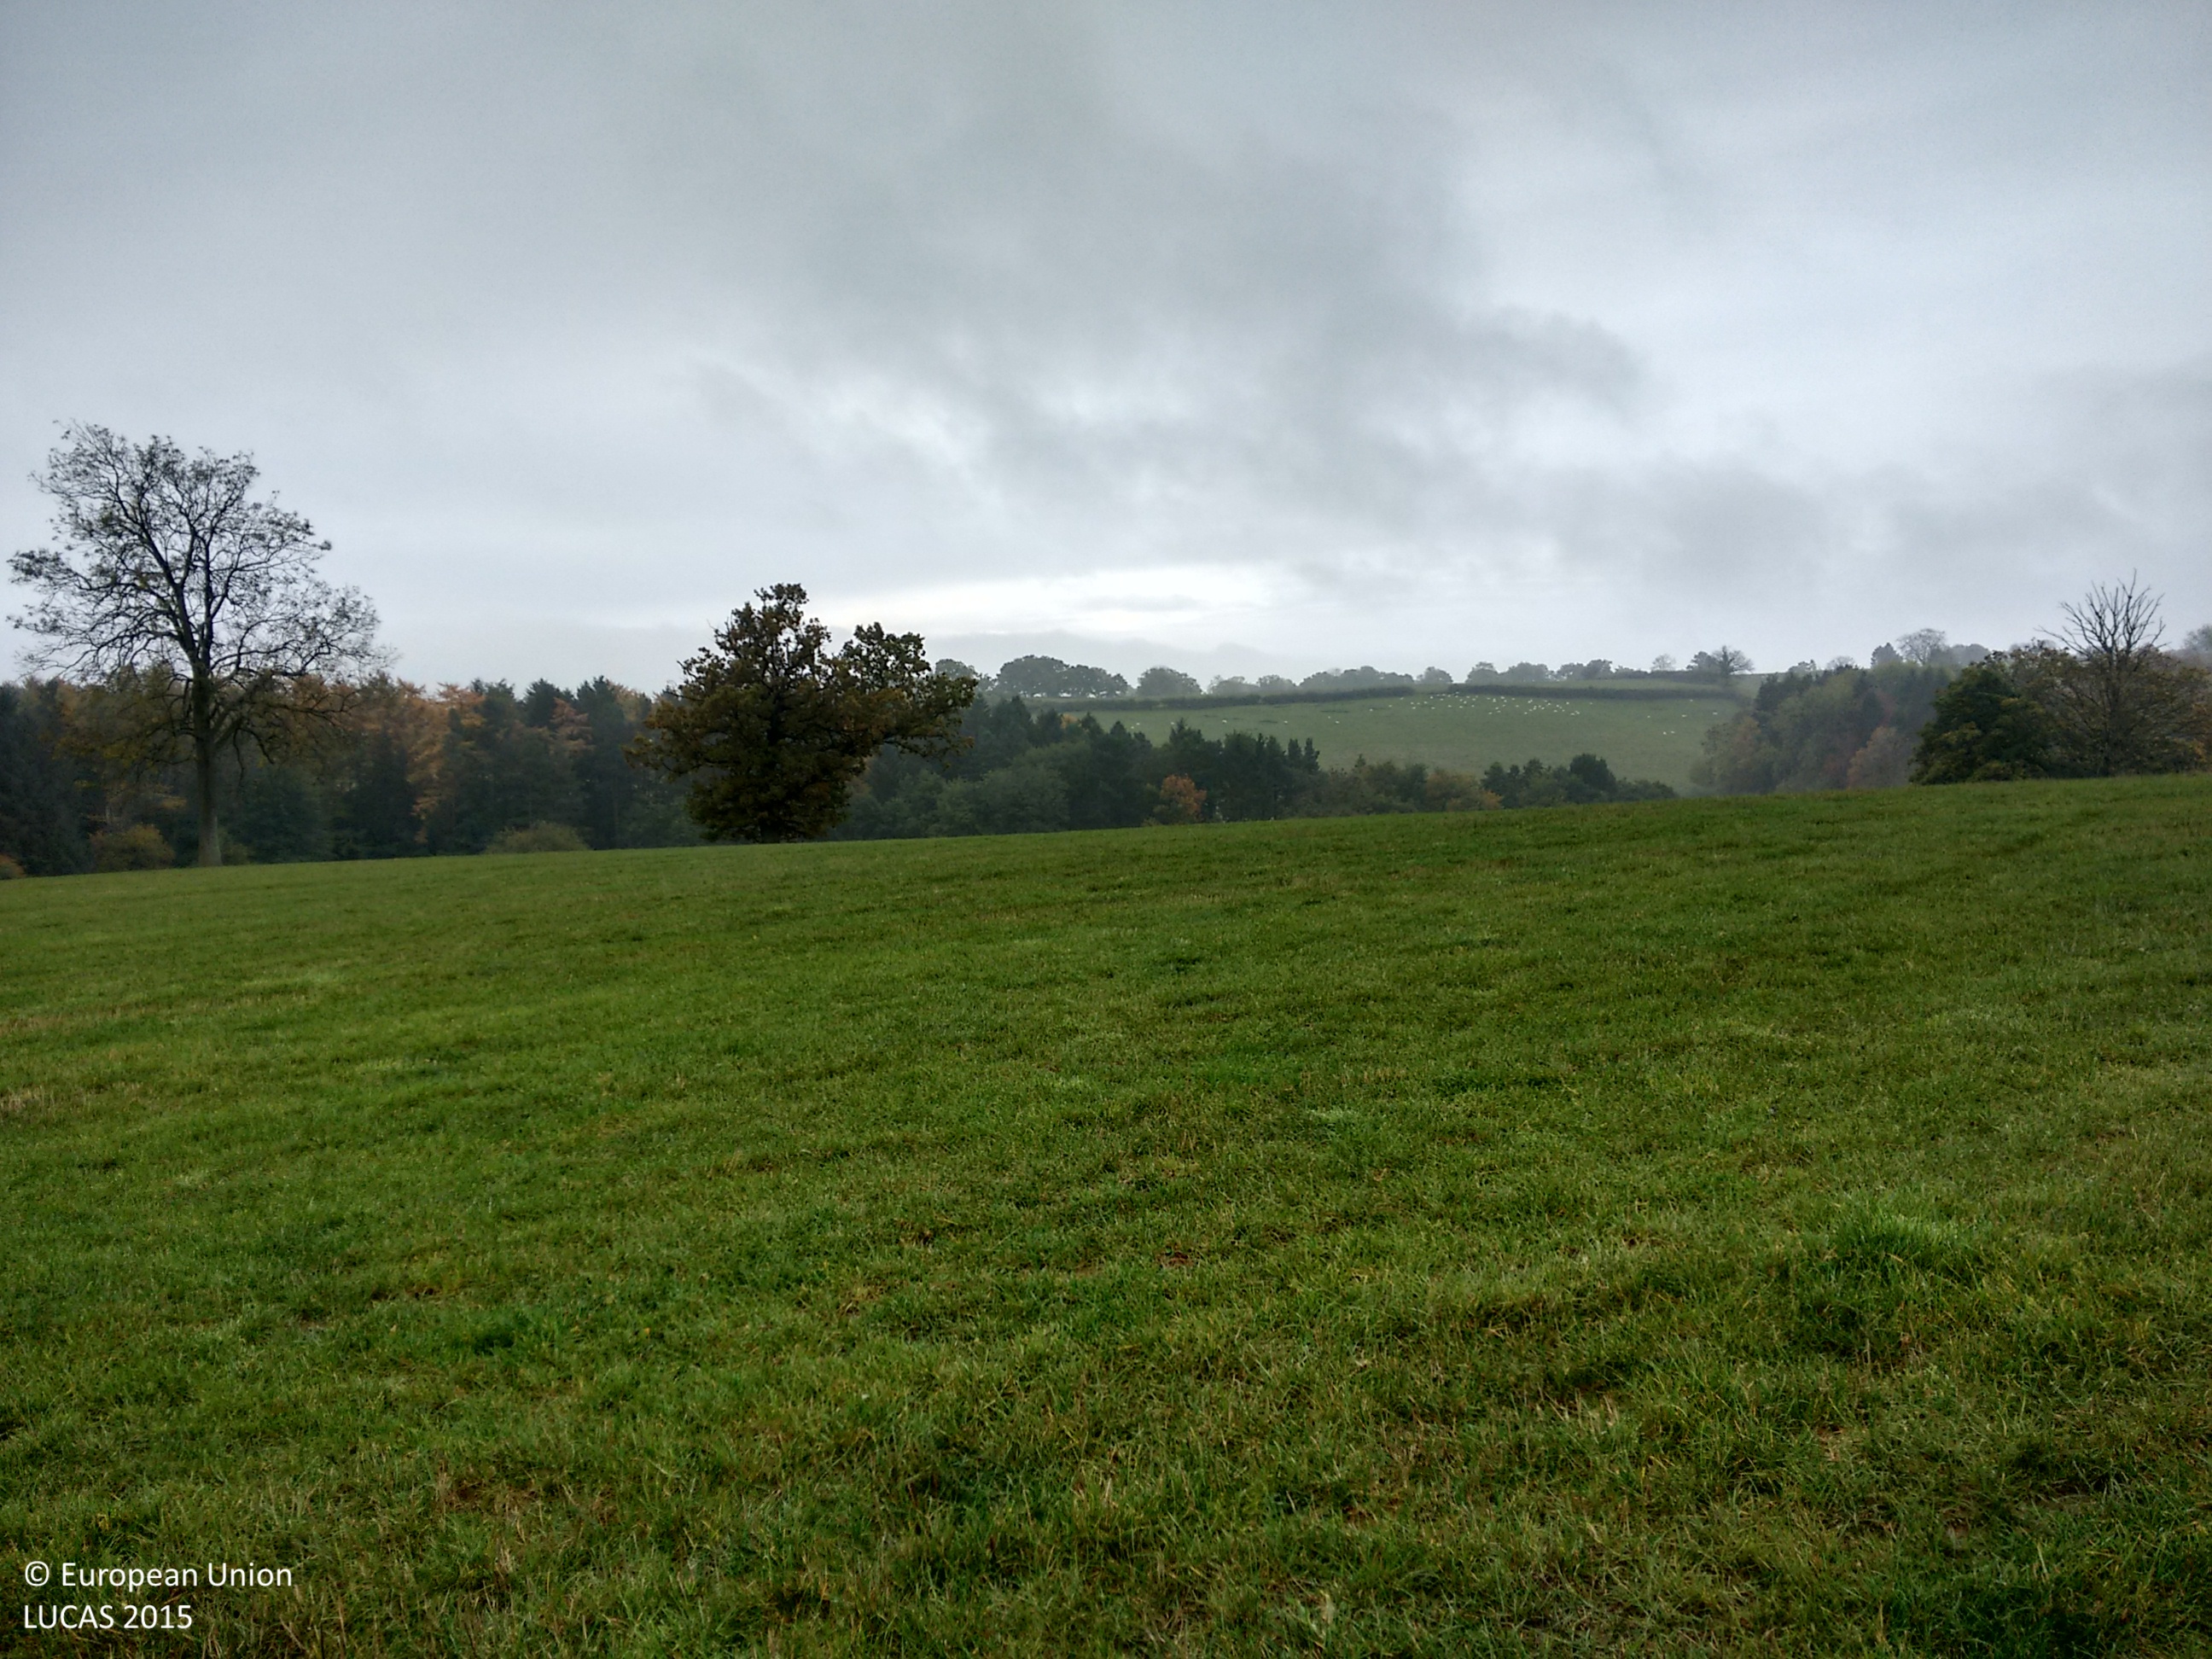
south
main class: Grassland
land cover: Grassland without tree/shrub cover
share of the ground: > 75 %
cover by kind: herbaceous plants 100 %
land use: Agriculture (excluding fallow land and kitchen gardens)
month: October
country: GB
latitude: 52.4626
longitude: -2.4734
